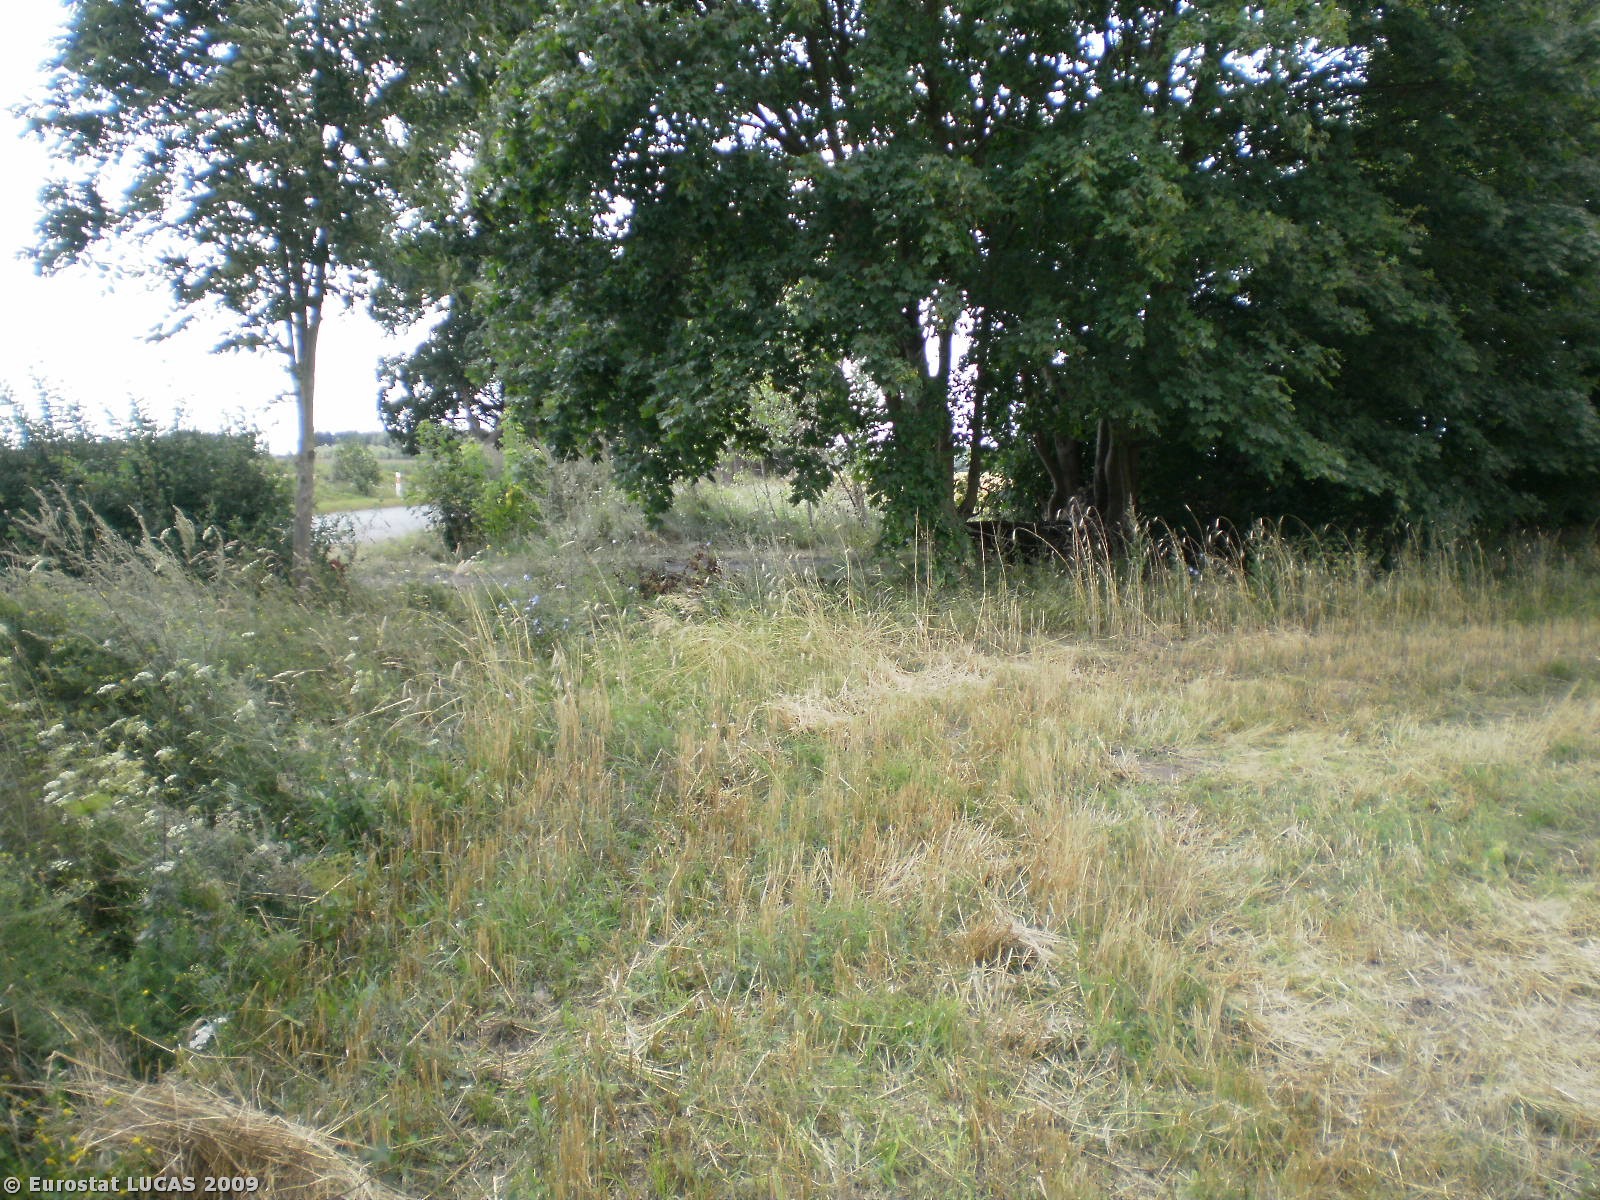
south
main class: Cropland
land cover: Rye
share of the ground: < 10 %
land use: Agriculture (excluding fallow land and kitchen gardens)
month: August
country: PL
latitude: 53.2155
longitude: 21.8713
